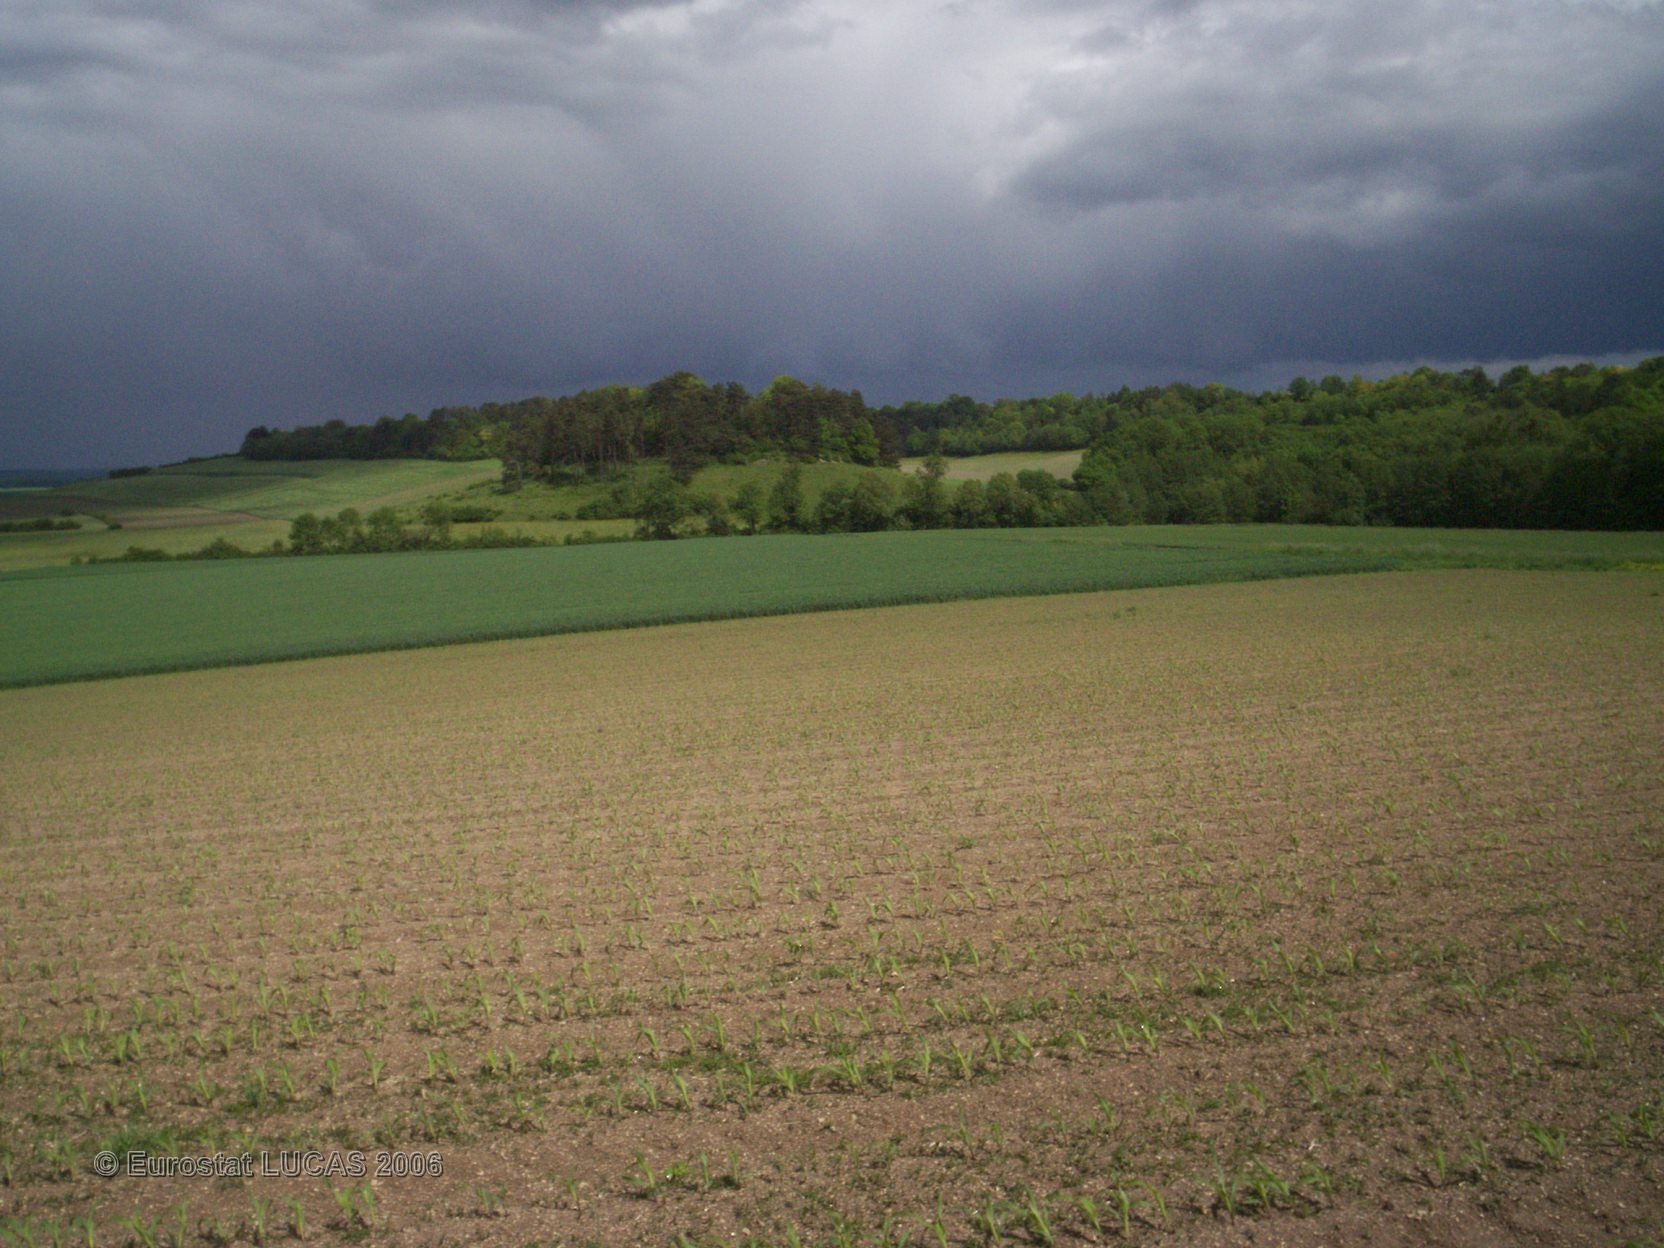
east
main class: Cropland
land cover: Maize
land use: Agriculture (excluding fallow land and kitchen gardens)
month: May
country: FR
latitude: 49.4244
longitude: 4.5784
